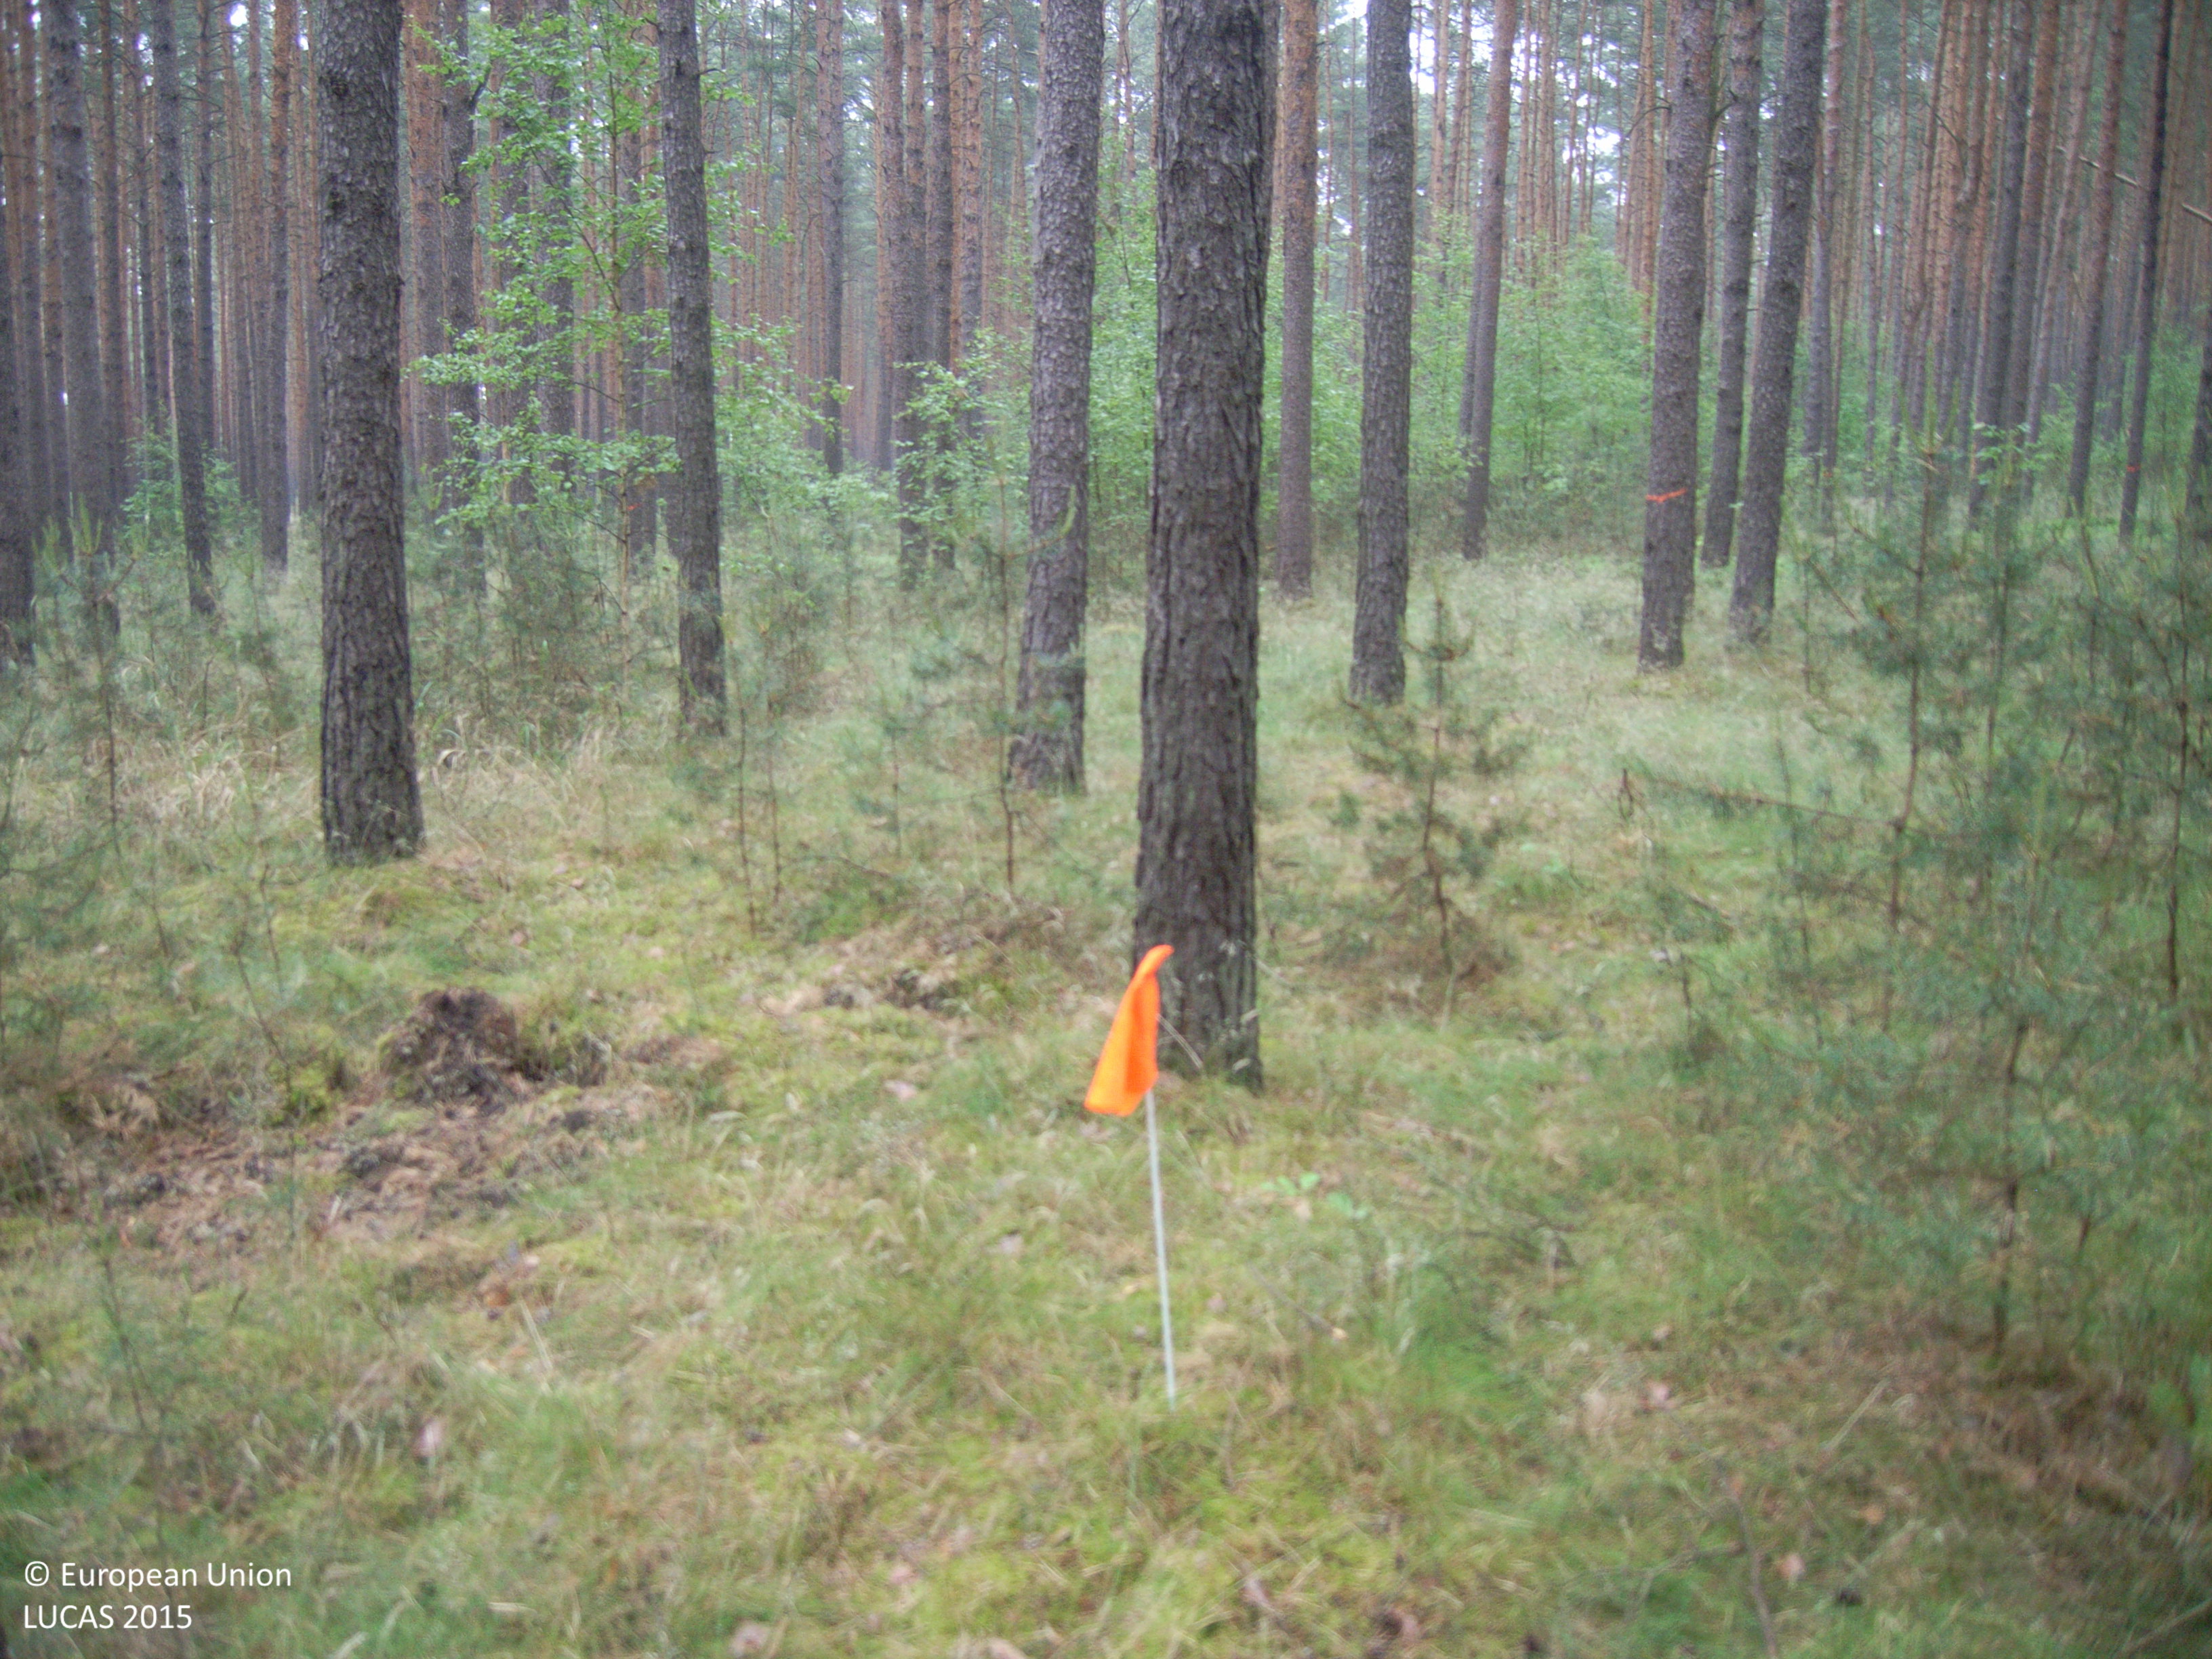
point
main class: Woodland
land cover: Pine dominated coniferous woodland
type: hemiboreal forest and nemoral coniferous forest and mixed broadleaved-coniferous forest
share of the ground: > 75 %
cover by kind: coniferous forest trees 90 %, broadleaved forest trees 5 %, herbaceous plants 5 %
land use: Forestry
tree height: > 5 m
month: June
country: DE
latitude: 52.3249
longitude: 14.0946
